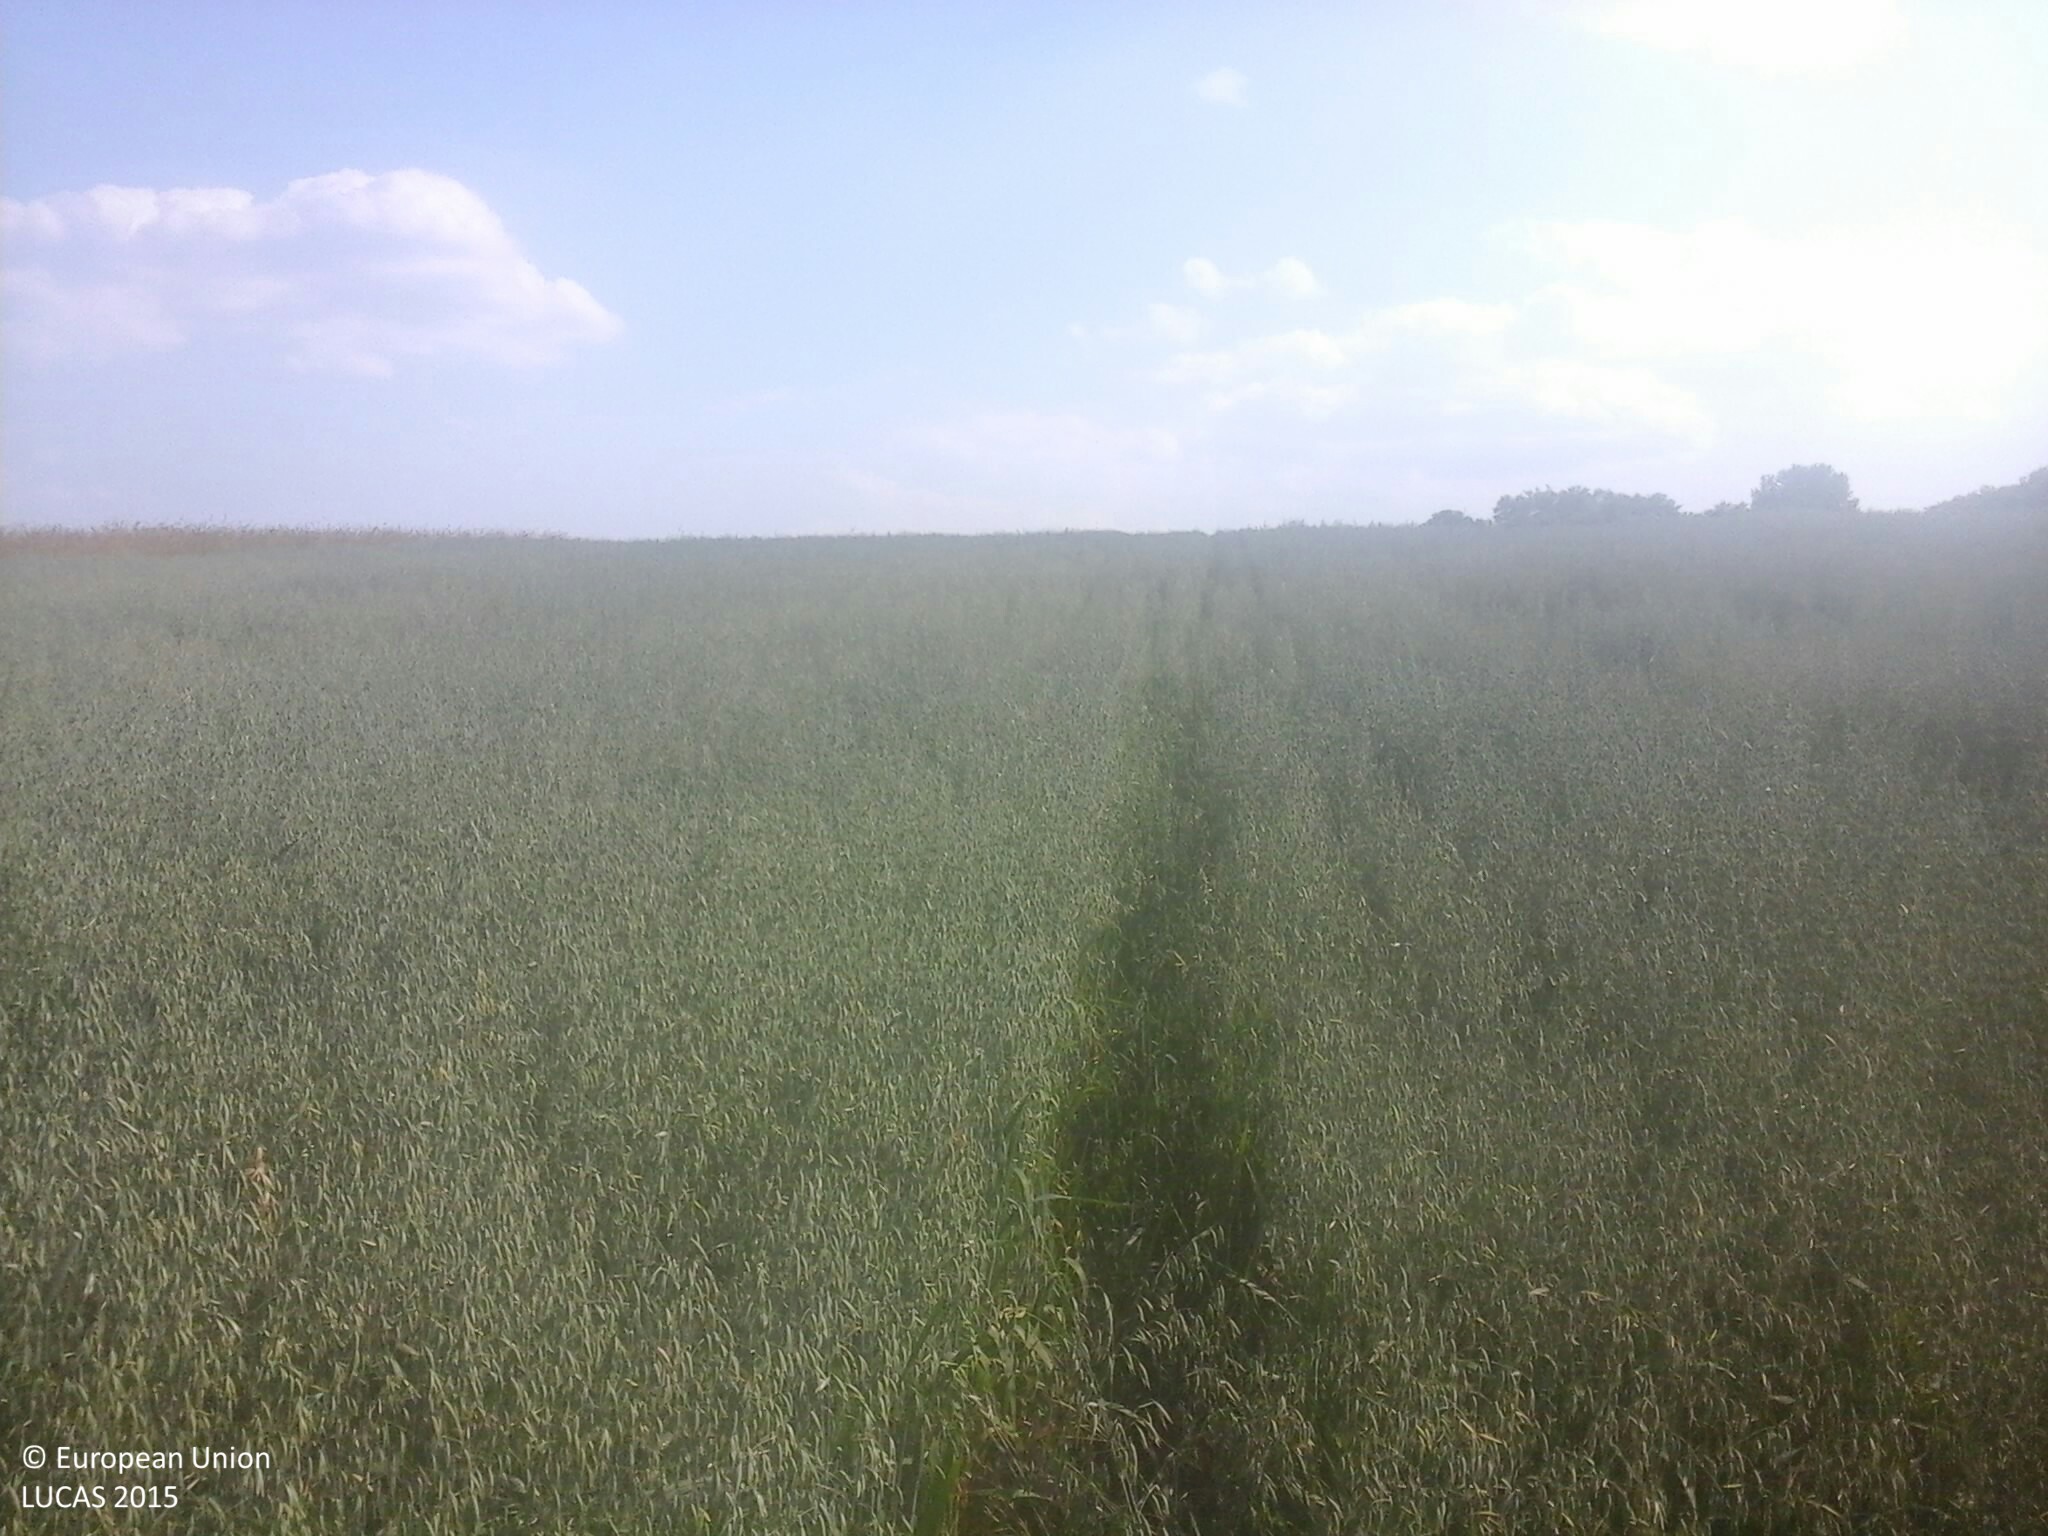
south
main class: Cropland
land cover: Oats
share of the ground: > 75 %
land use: Agriculture (excluding fallow land and kitchen gardens)
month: July
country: HU
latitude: 47.2905
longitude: 17.8770
